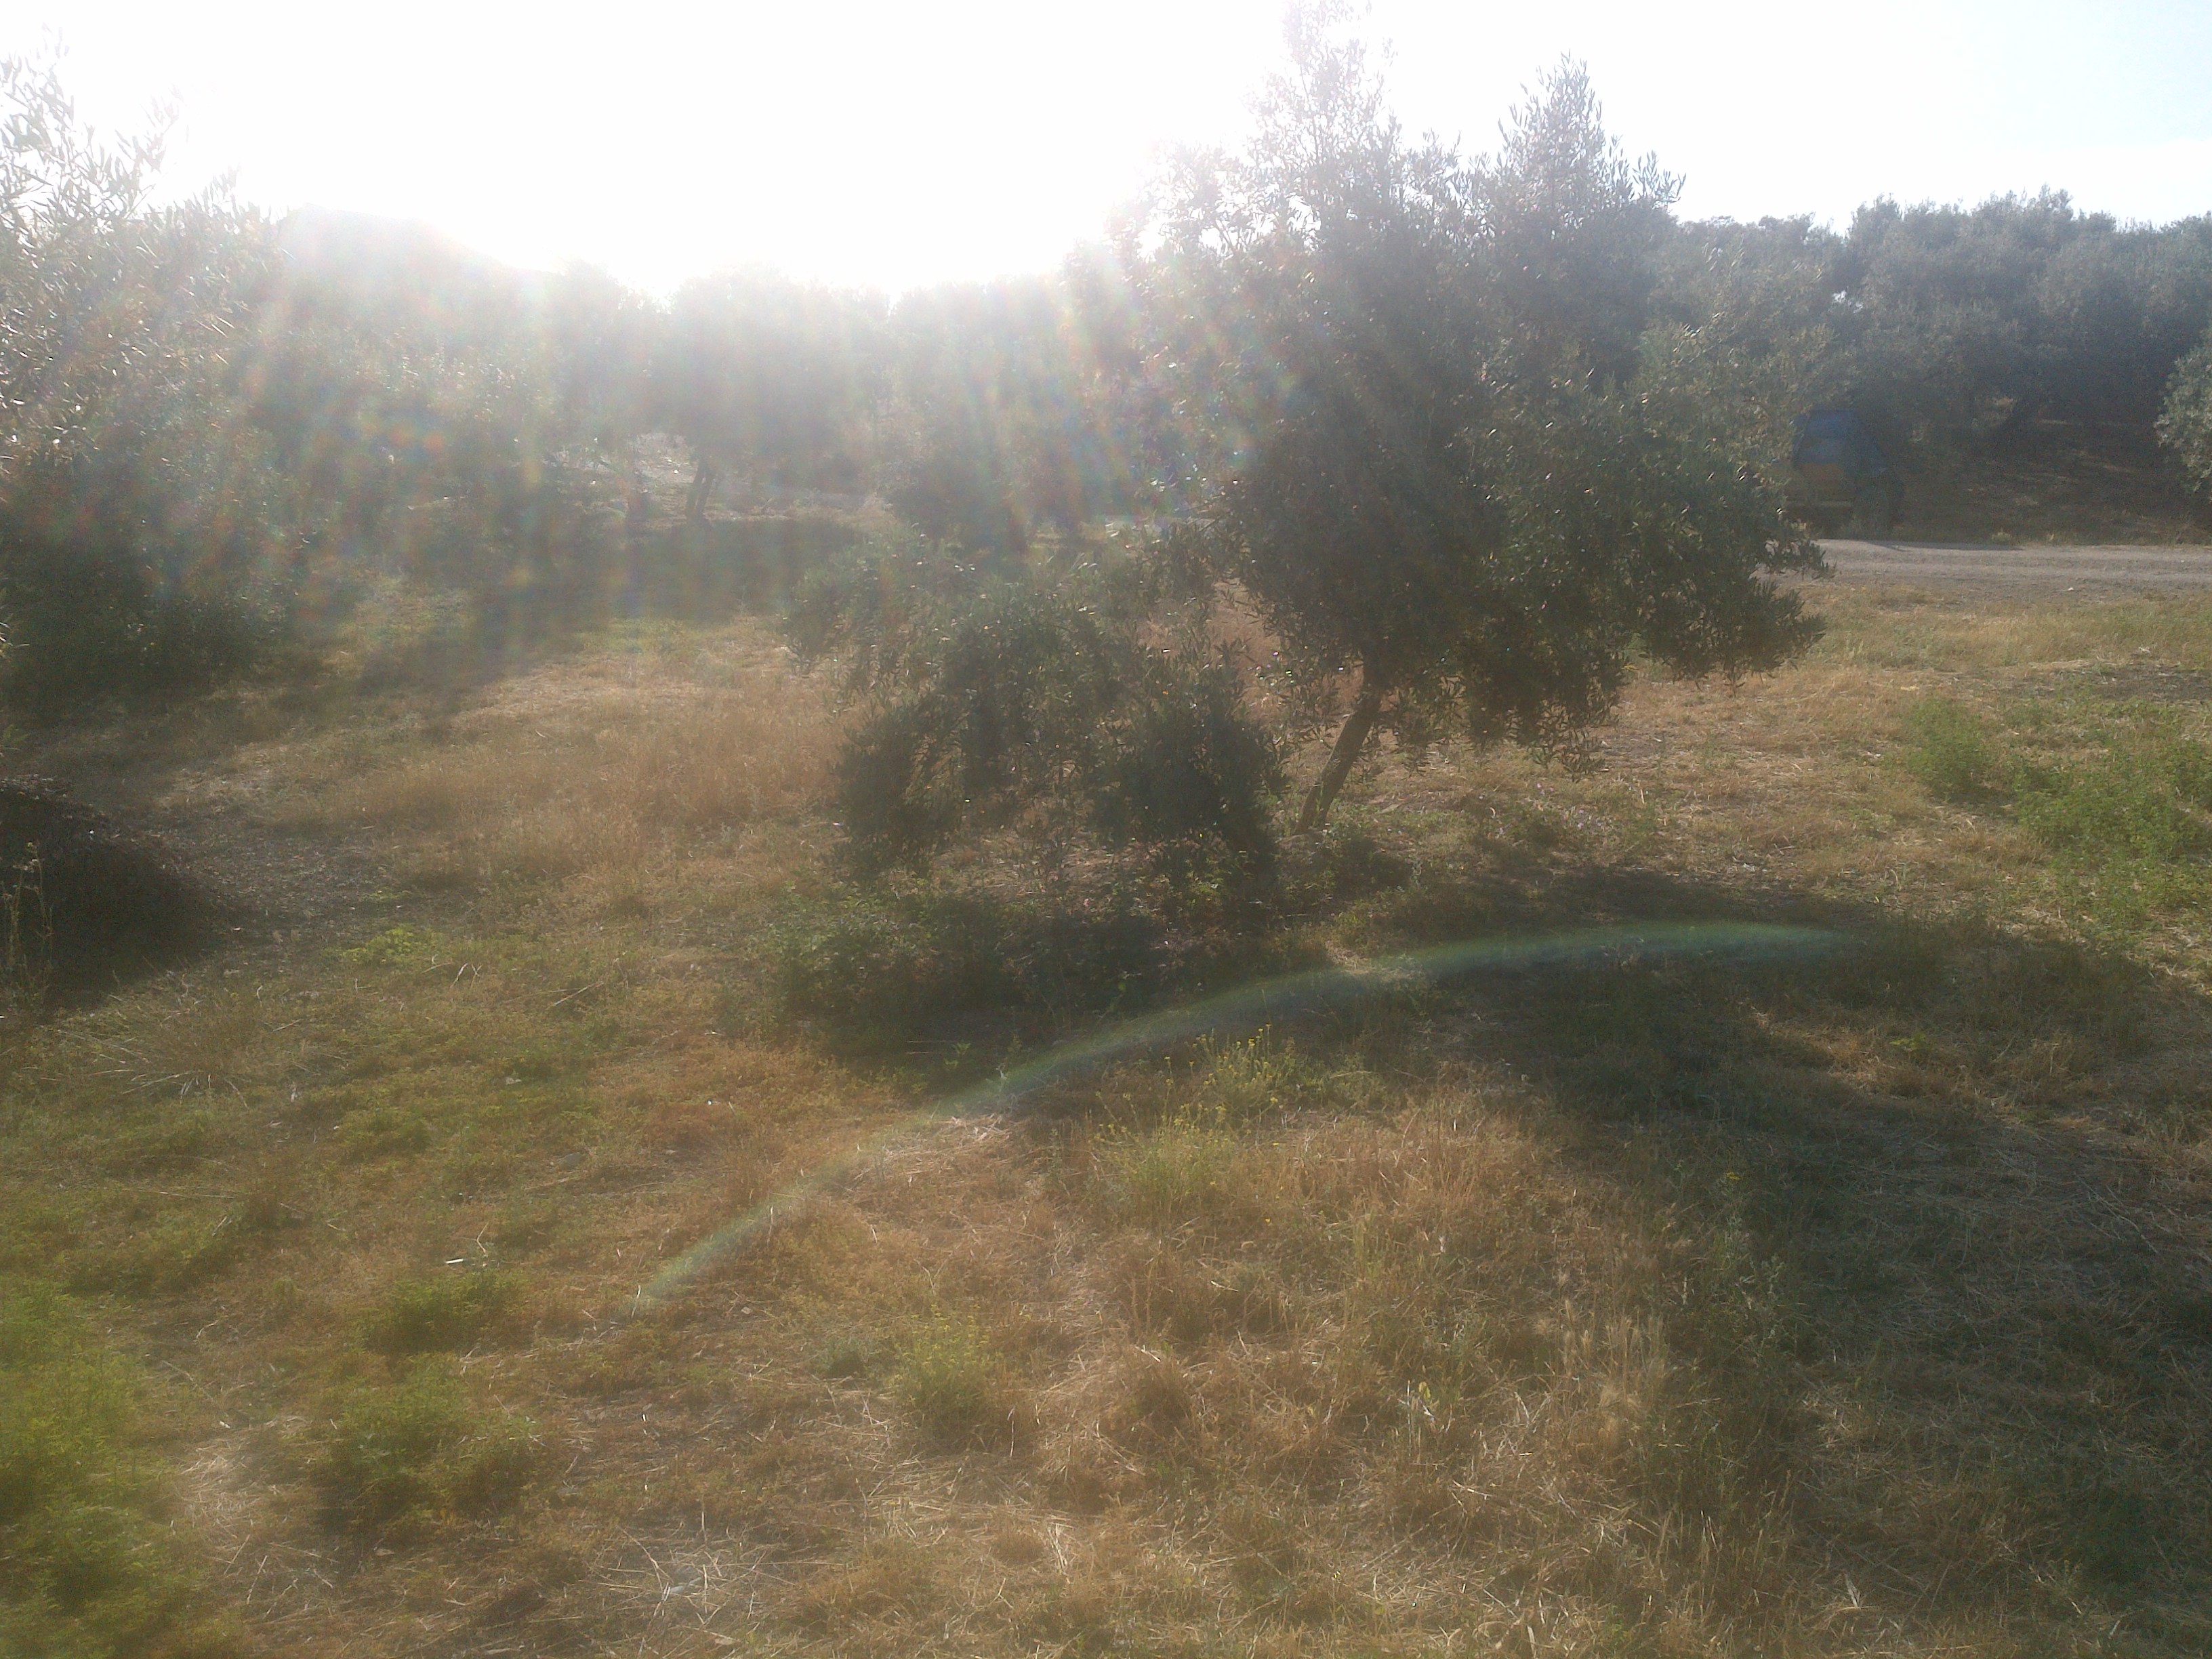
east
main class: Cropland
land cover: Olive groves
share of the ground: 25 - 50 %
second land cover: Spontaneously vegetated surfaces
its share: 50 - 75 %
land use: Agriculture (excluding fallow land and kitchen gardens)
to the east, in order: Olive groves; Spontaneously vegetated surfaces; Tracks; Grass margins; Olive groves; Grass margins; Tracks; Olive groves; Fences; Olive groves; Tracks; Olive groves; Fences; Olive groves
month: May
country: ES
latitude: 37.4634
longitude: -4.0976
